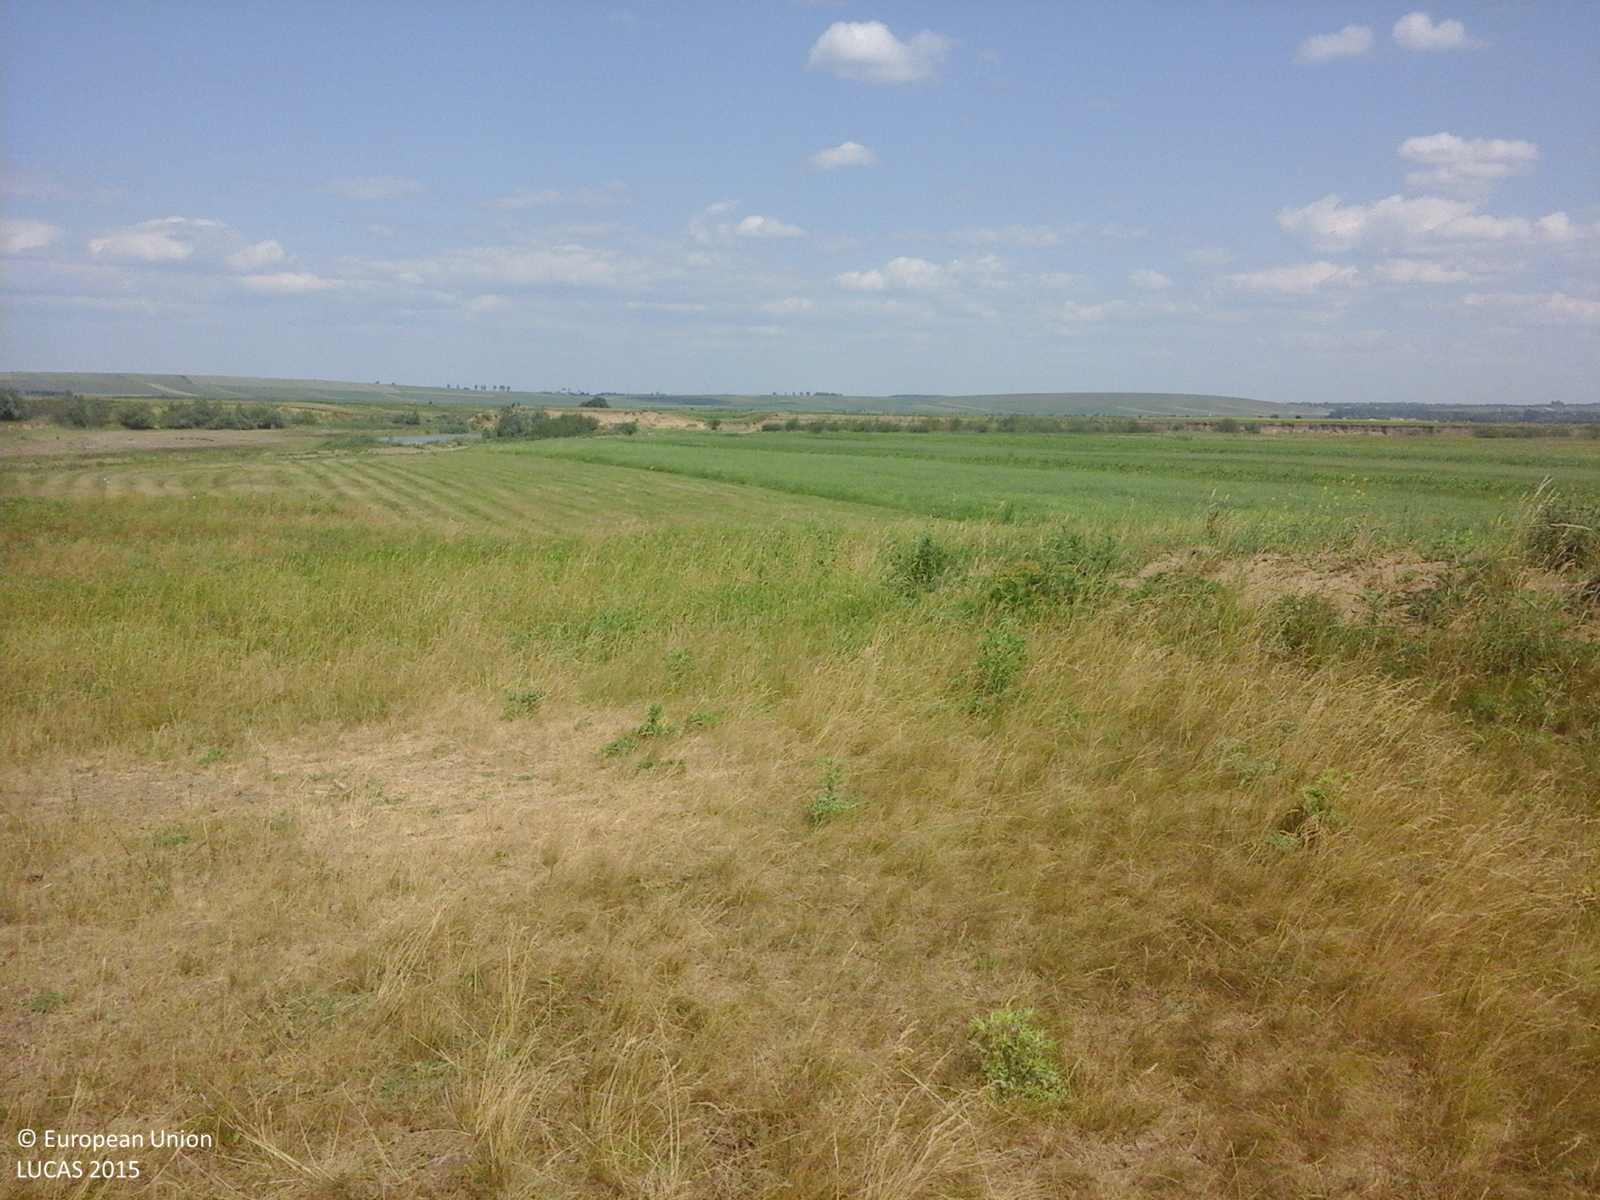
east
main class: Grassland
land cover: Grassland without tree/shrub cover
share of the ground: > 75 %
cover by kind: herbaceous plants 100 %
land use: Agriculture (excluding fallow land and kitchen gardens)
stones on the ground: < 10 %
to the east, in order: Grassland without tree/shrub cover; Oats; Maize; Dry pulses; Oats; Spontaneously vegetated surfaces
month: June
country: RO
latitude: 47.6691
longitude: 26.4839
